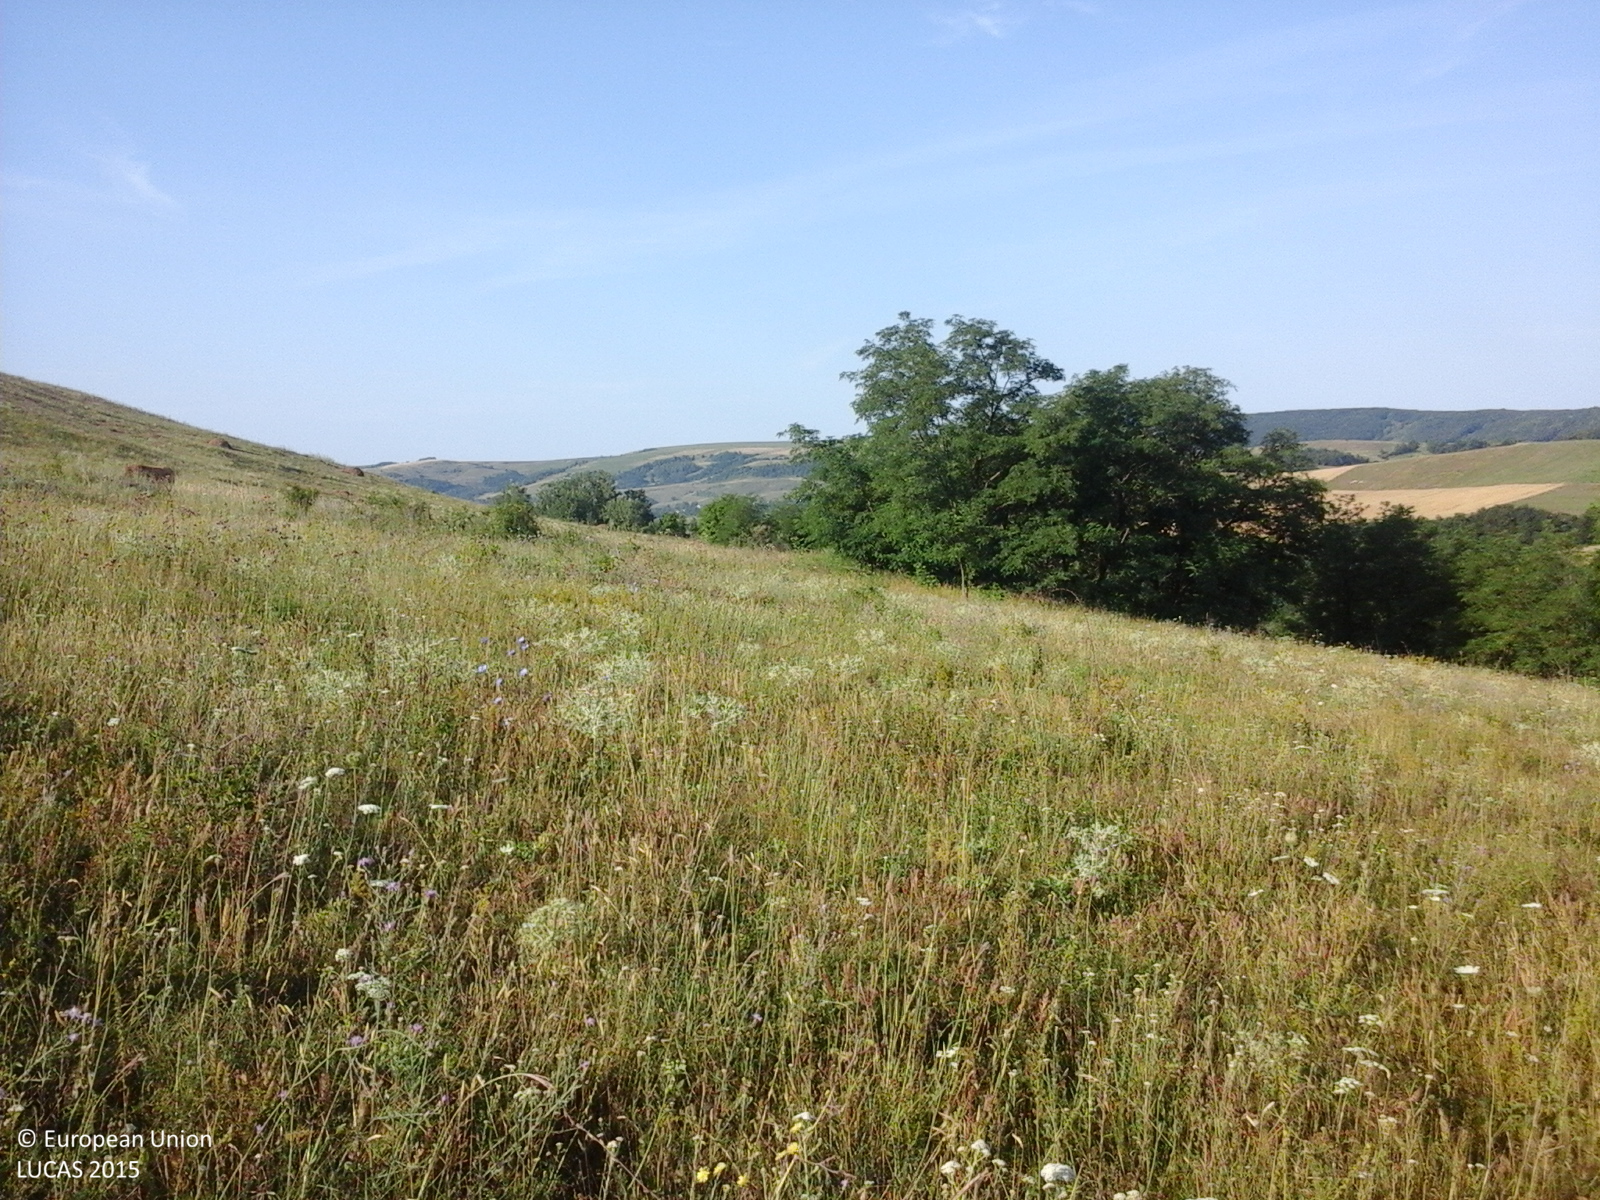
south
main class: Grassland
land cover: Grassland without tree/shrub cover
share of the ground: > 75 %
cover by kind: herbaceous plants 100 %
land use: Agriculture (excluding fallow land and kitchen gardens)
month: July
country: RO
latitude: 46.5844
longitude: 27.1850
